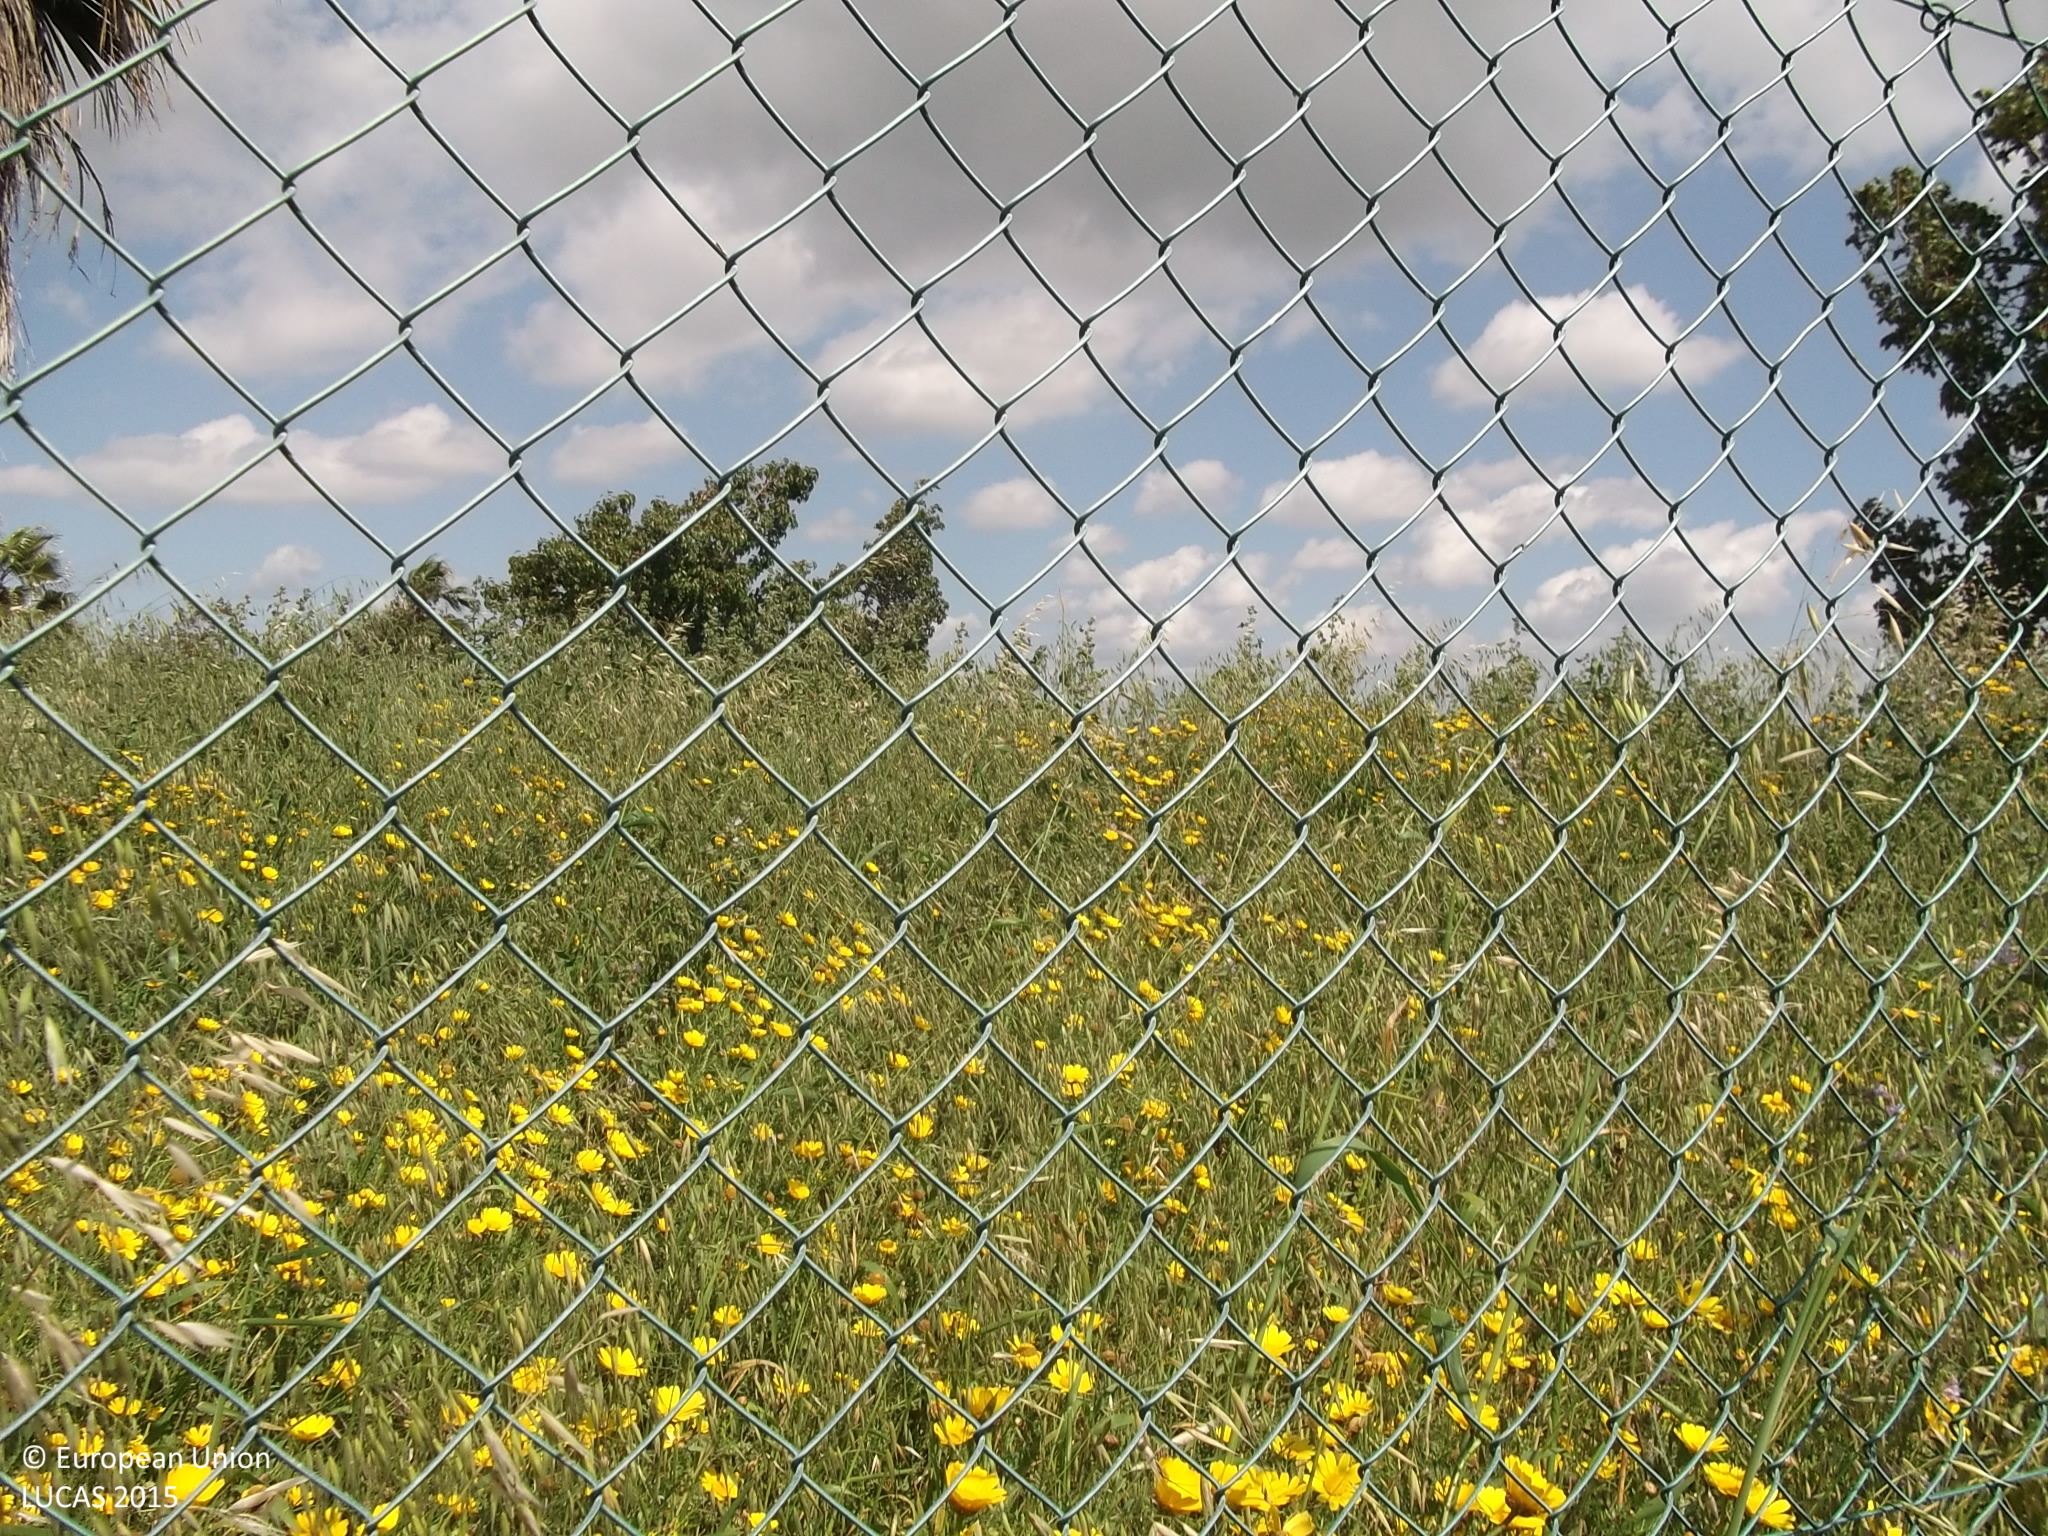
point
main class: Grassland
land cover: Grassland with sparse tree/shrub cover
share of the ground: > 75 %
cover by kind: herbaceous plants 95 %, broadleaved forest trees 5 %
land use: Semi-natural and natural areas not in use
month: April
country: CY
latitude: 34.8832
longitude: 33.5972
